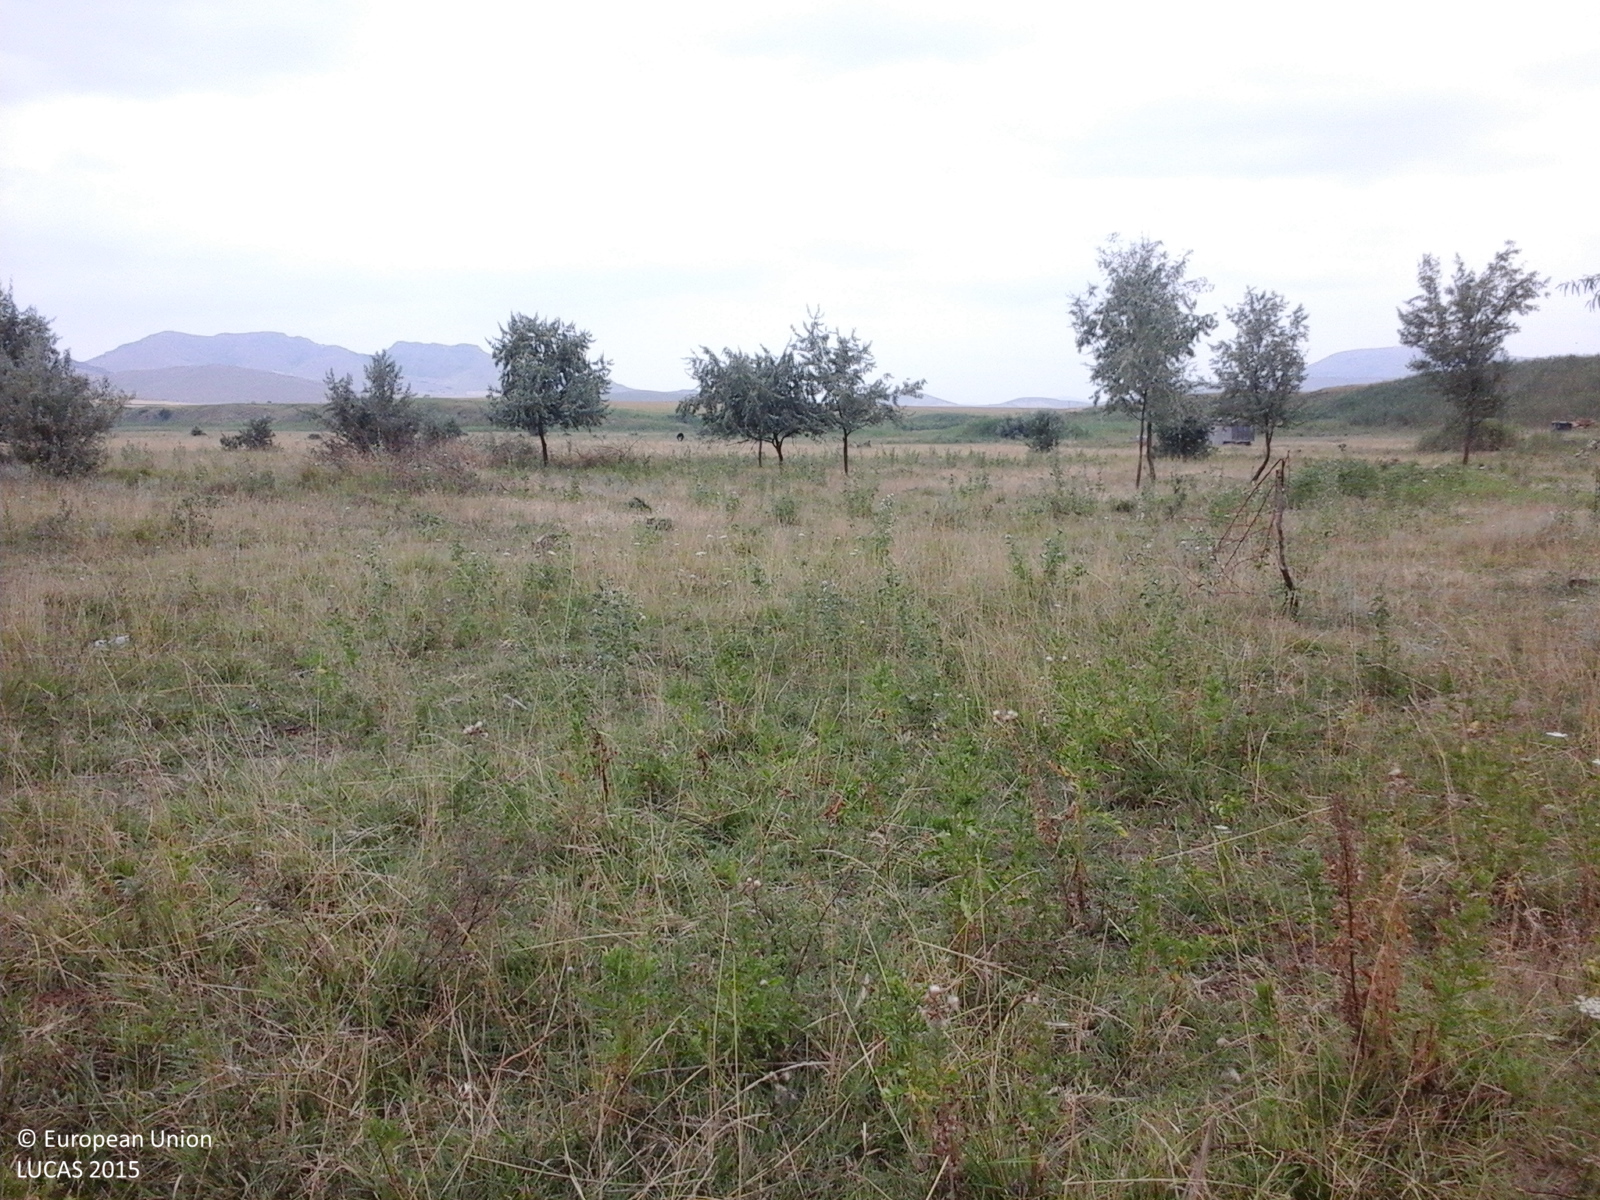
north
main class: Grassland
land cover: Grassland with sparse tree/shrub cover
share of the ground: > 75 %
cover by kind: herbaceous plants 85 %, shrubs 10 %, broadleaved forest trees 5 %
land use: Semi-natural and natural areas not in use
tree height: > 5 m
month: July
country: RO
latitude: 45.0645
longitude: 28.2180
